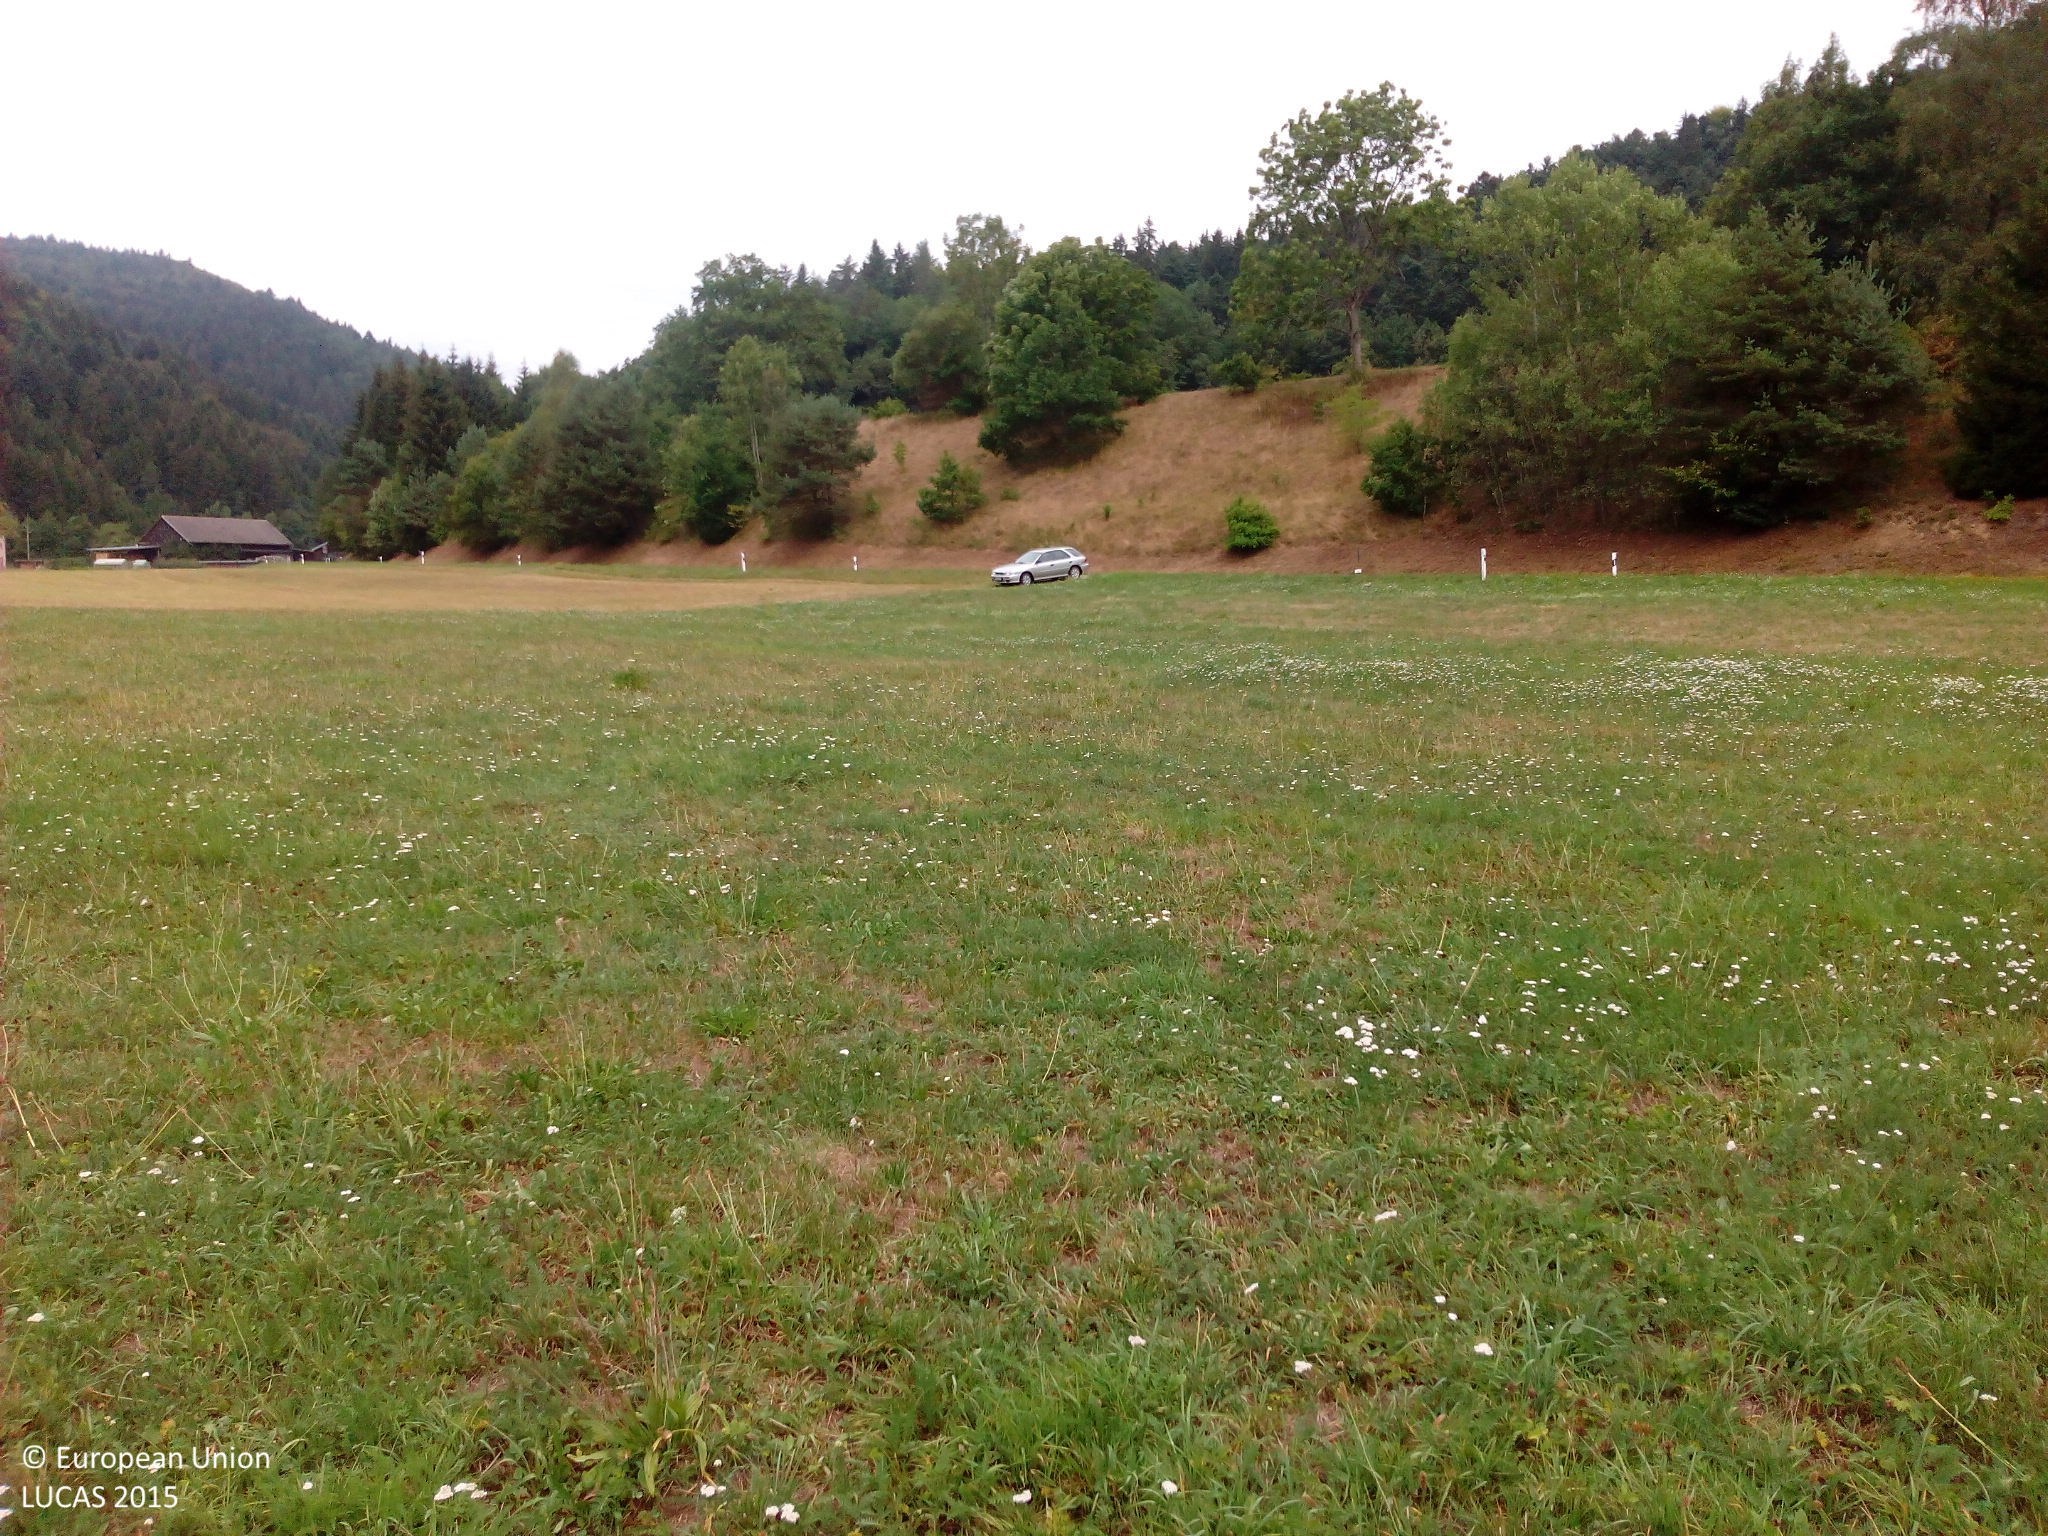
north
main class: Grassland
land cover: Grassland without tree/shrub cover
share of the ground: > 75 %
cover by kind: herbaceous plants 85 %, unconsolidated bare surface 15 %
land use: Agriculture (excluding fallow land and kitchen gardens)
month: August
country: DE
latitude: 47.6855
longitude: 8.1229
